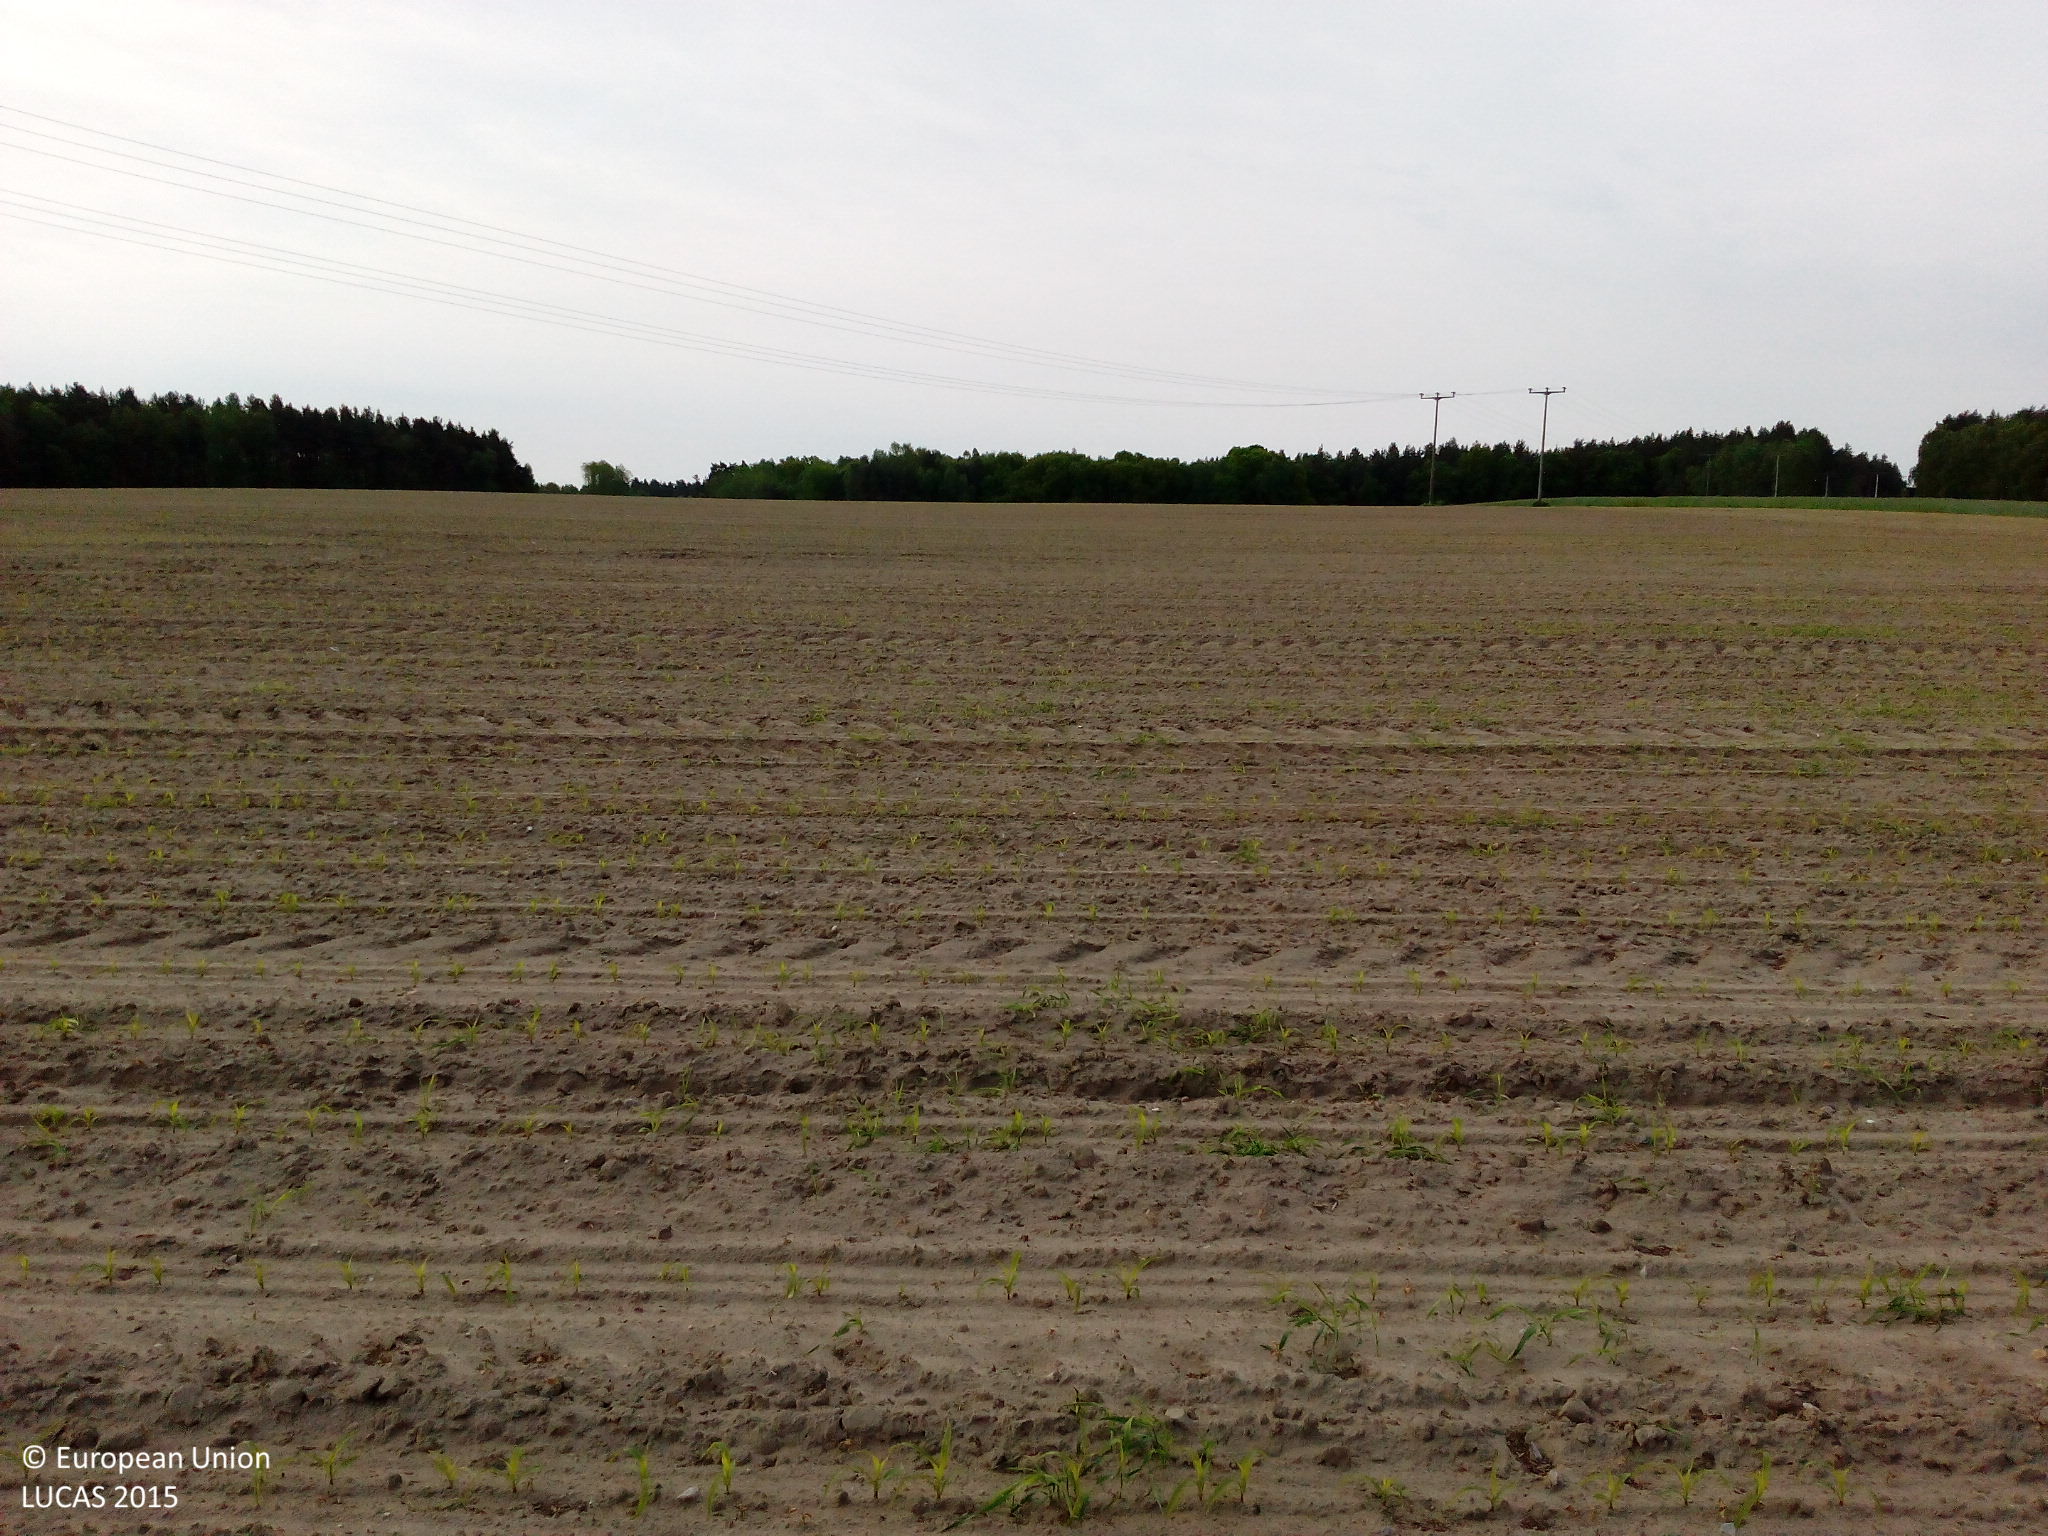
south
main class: Cropland
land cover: Maize
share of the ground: < 10 %
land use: Agriculture (excluding fallow land and kitchen gardens)
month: May
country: DE
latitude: 52.8214
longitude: 11.1422
